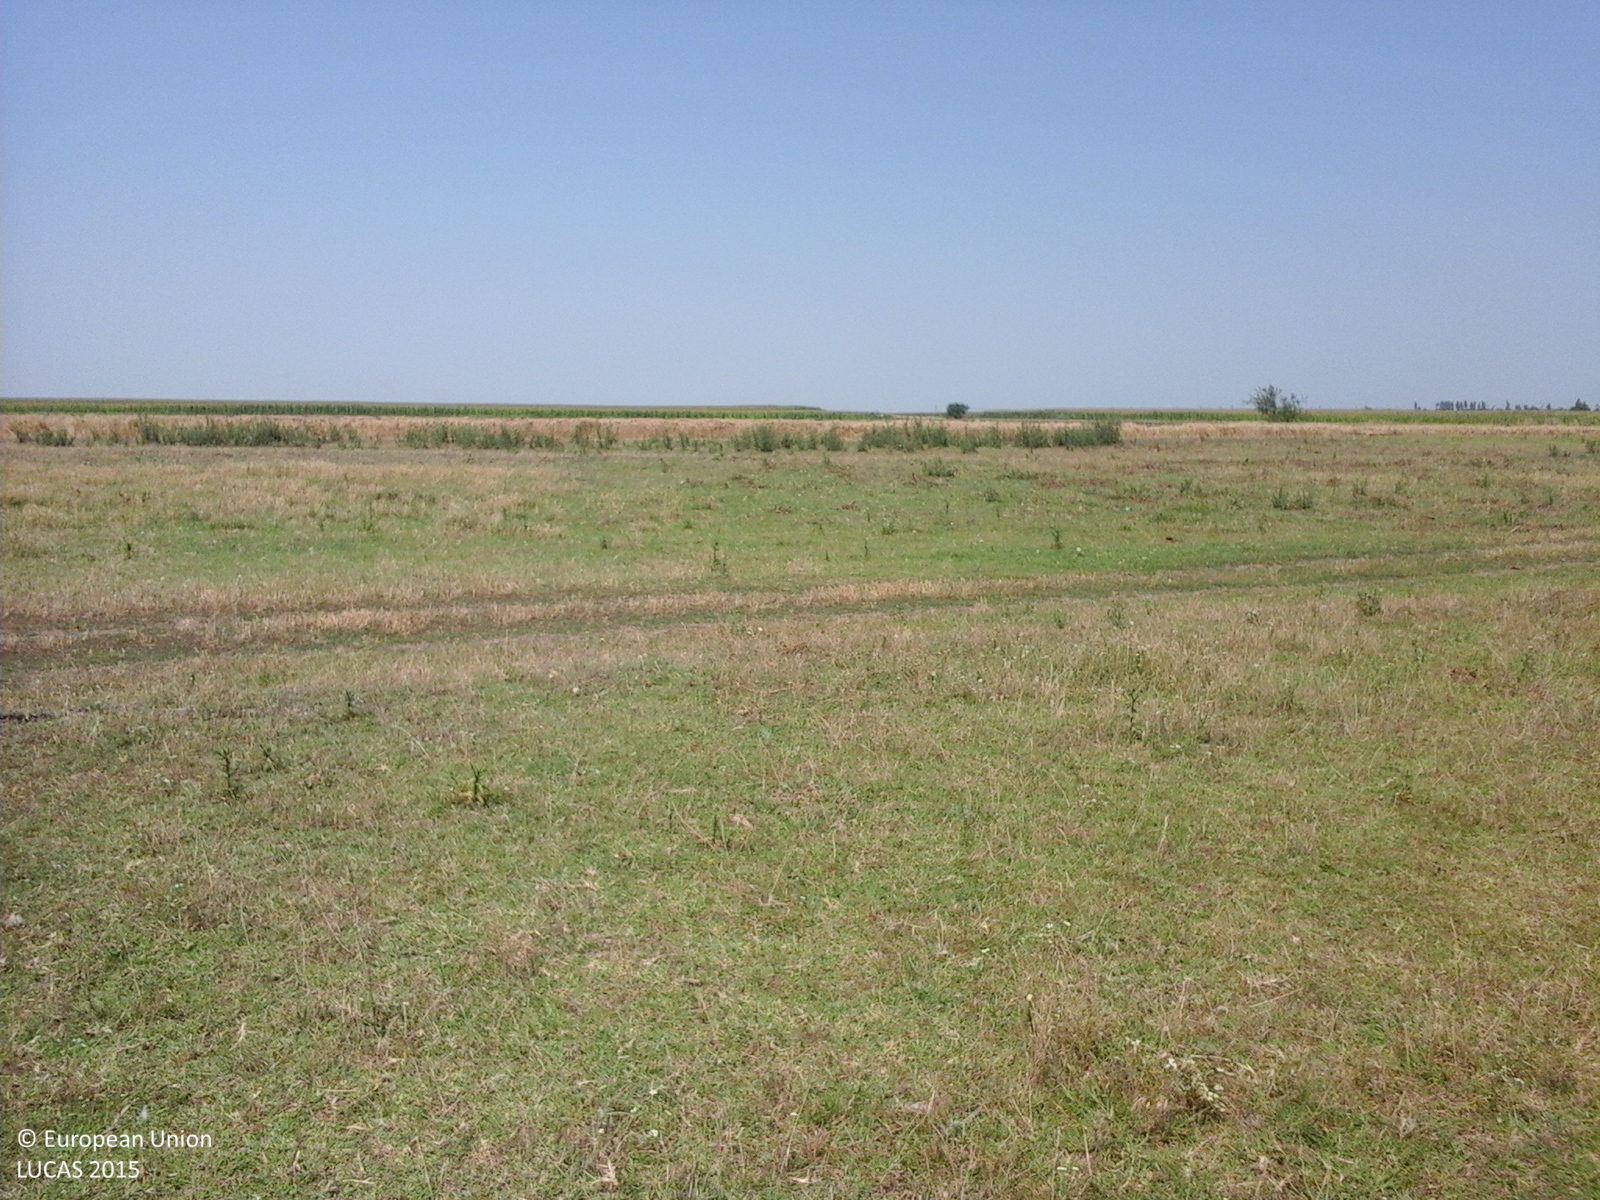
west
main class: Grassland
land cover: Grassland without tree/shrub cover
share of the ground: > 75 %
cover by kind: herbaceous plants 100 %
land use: Agriculture (excluding fallow land and kitchen gardens)
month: July
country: RO
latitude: 44.7292
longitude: 26.8317
